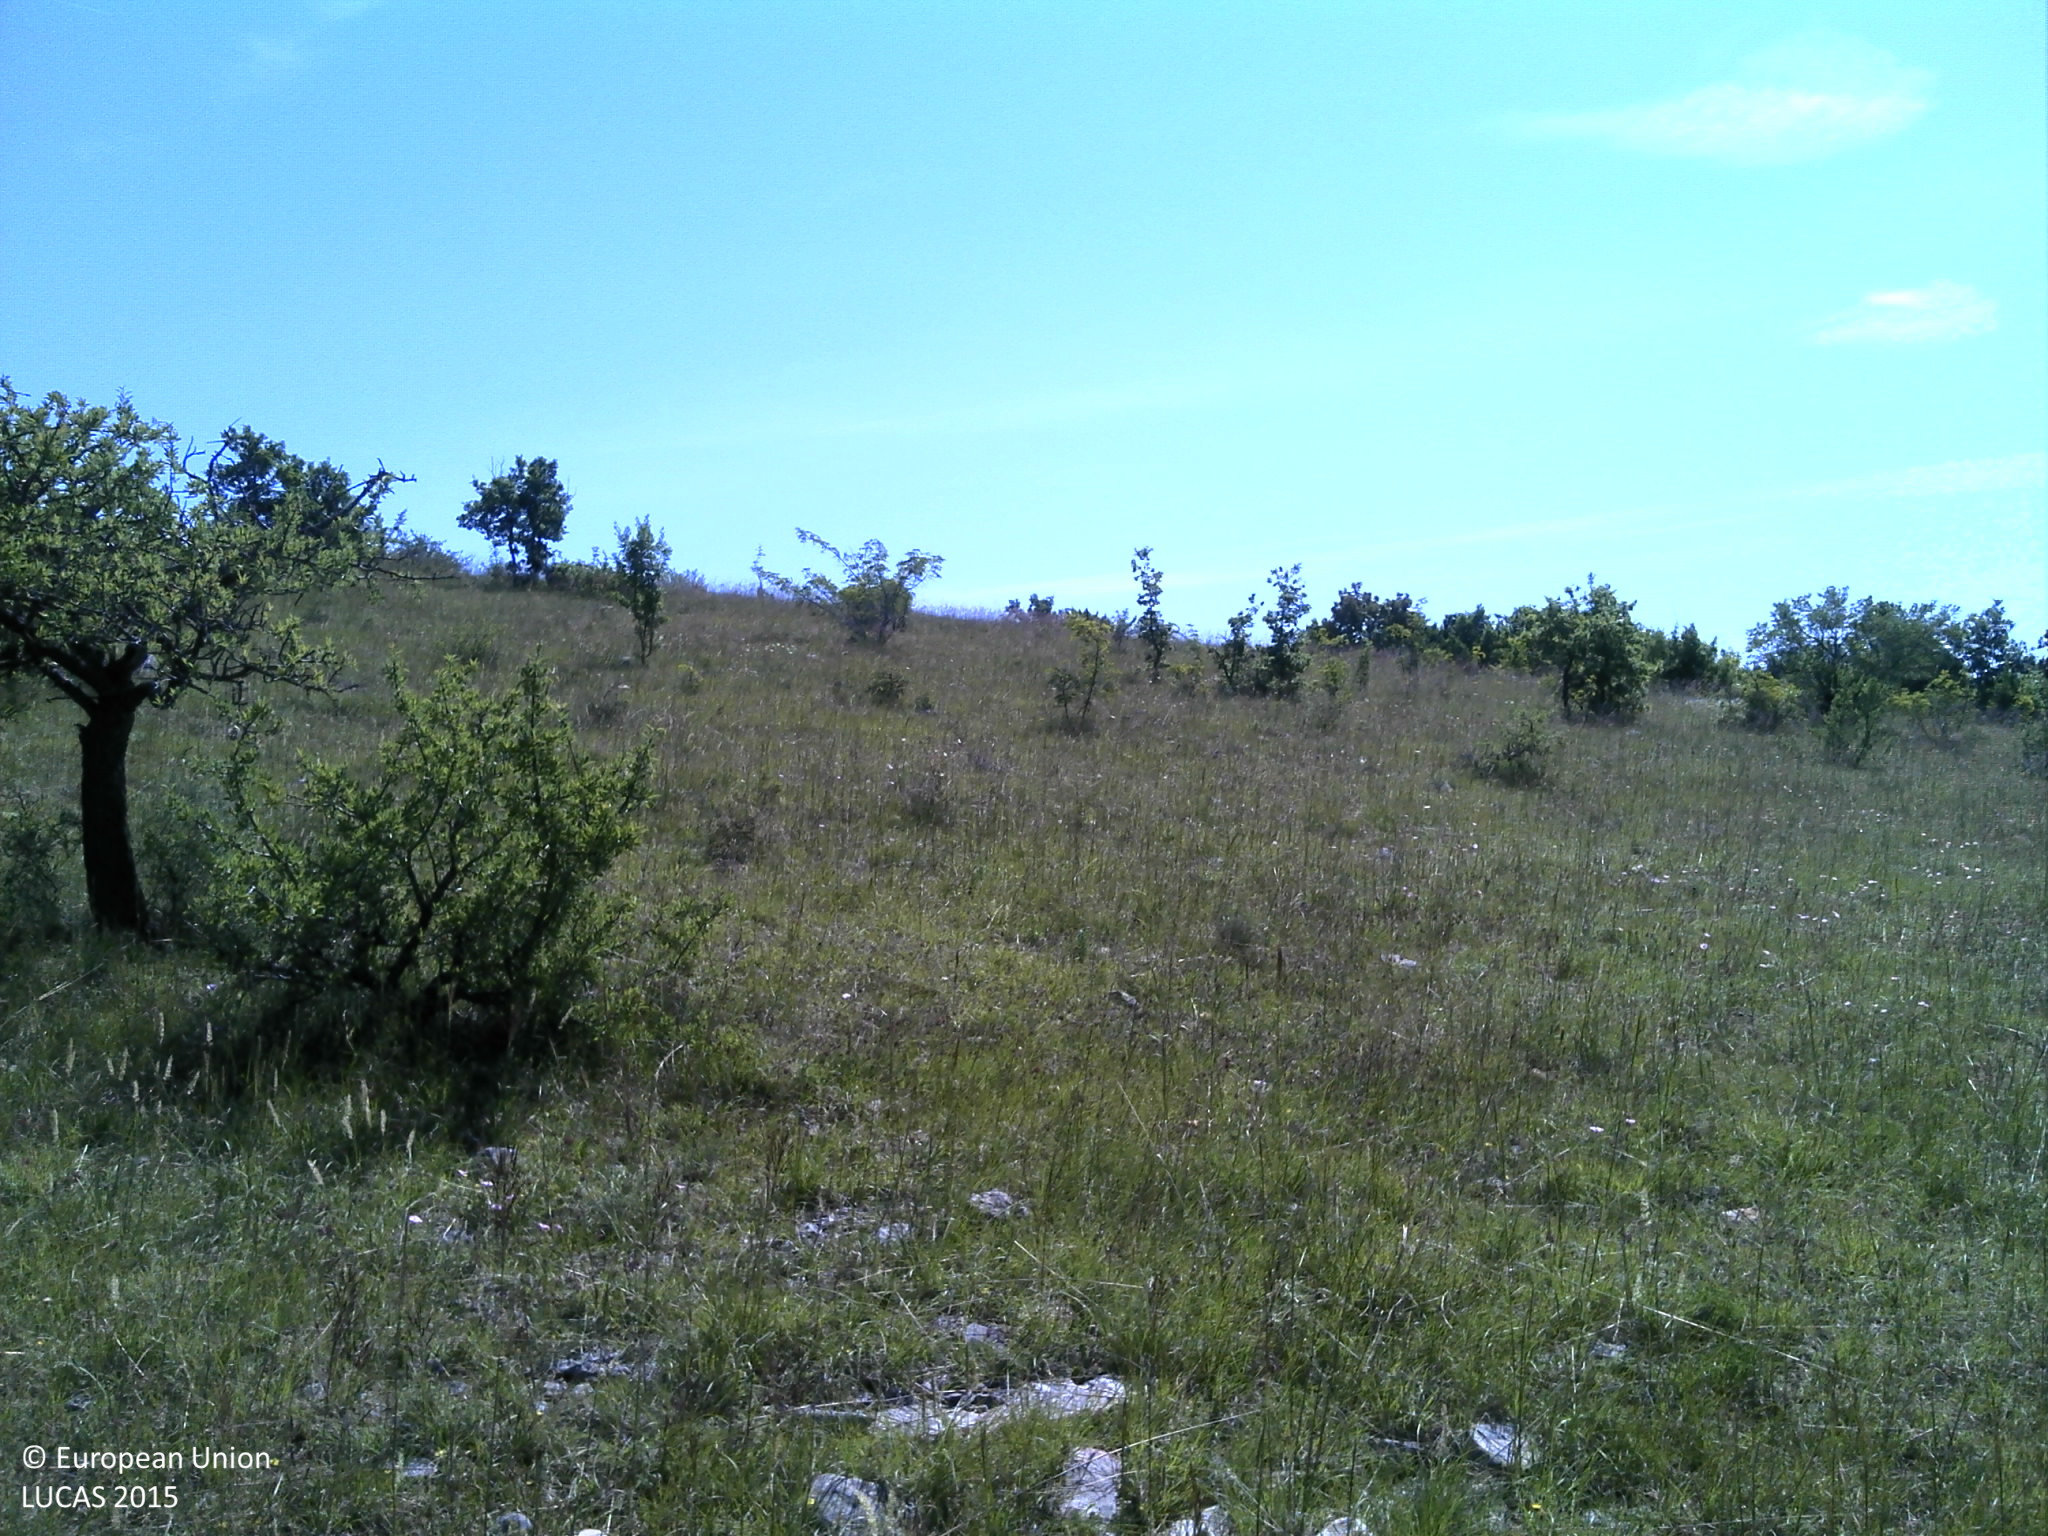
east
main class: Grassland
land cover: Grassland with sparse tree/shrub cover
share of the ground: > 75 %
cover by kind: herbaceous plants 80 %, shrubs 10 %, broadleaved forest trees 5 %, unconsolidated bare surface 5 %
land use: Abandoned areas
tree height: < 5 m
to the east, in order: Grassland with sparse tree/shrub cover; Broadleaved woodland; Shrubland with sparse tree cover; Broadleaved woodland
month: June
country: HR
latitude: 43.7498
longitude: 16.1884
